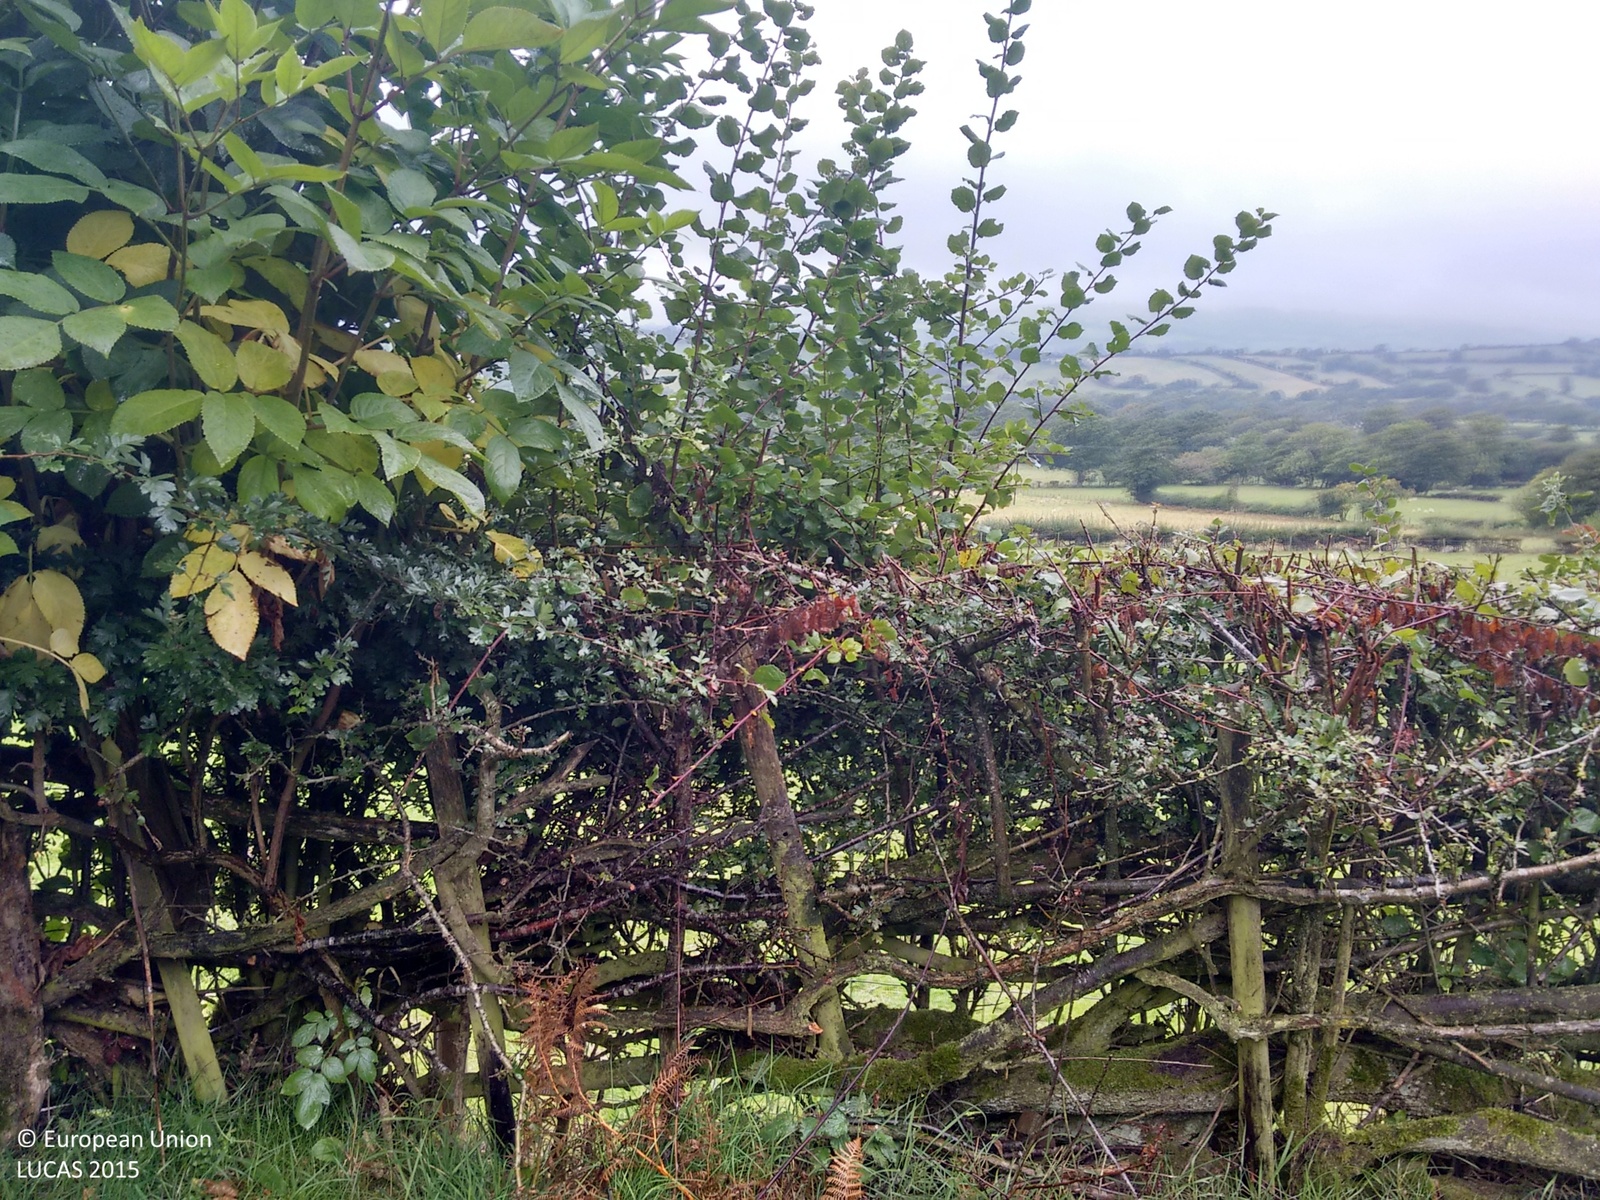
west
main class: Grassland
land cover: Grassland without tree/shrub cover
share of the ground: > 75 %
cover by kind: herbaceous plants 100 %
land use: Agriculture (excluding fallow land and kitchen gardens)
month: September
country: GB
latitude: 52.5280
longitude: -2.8820
